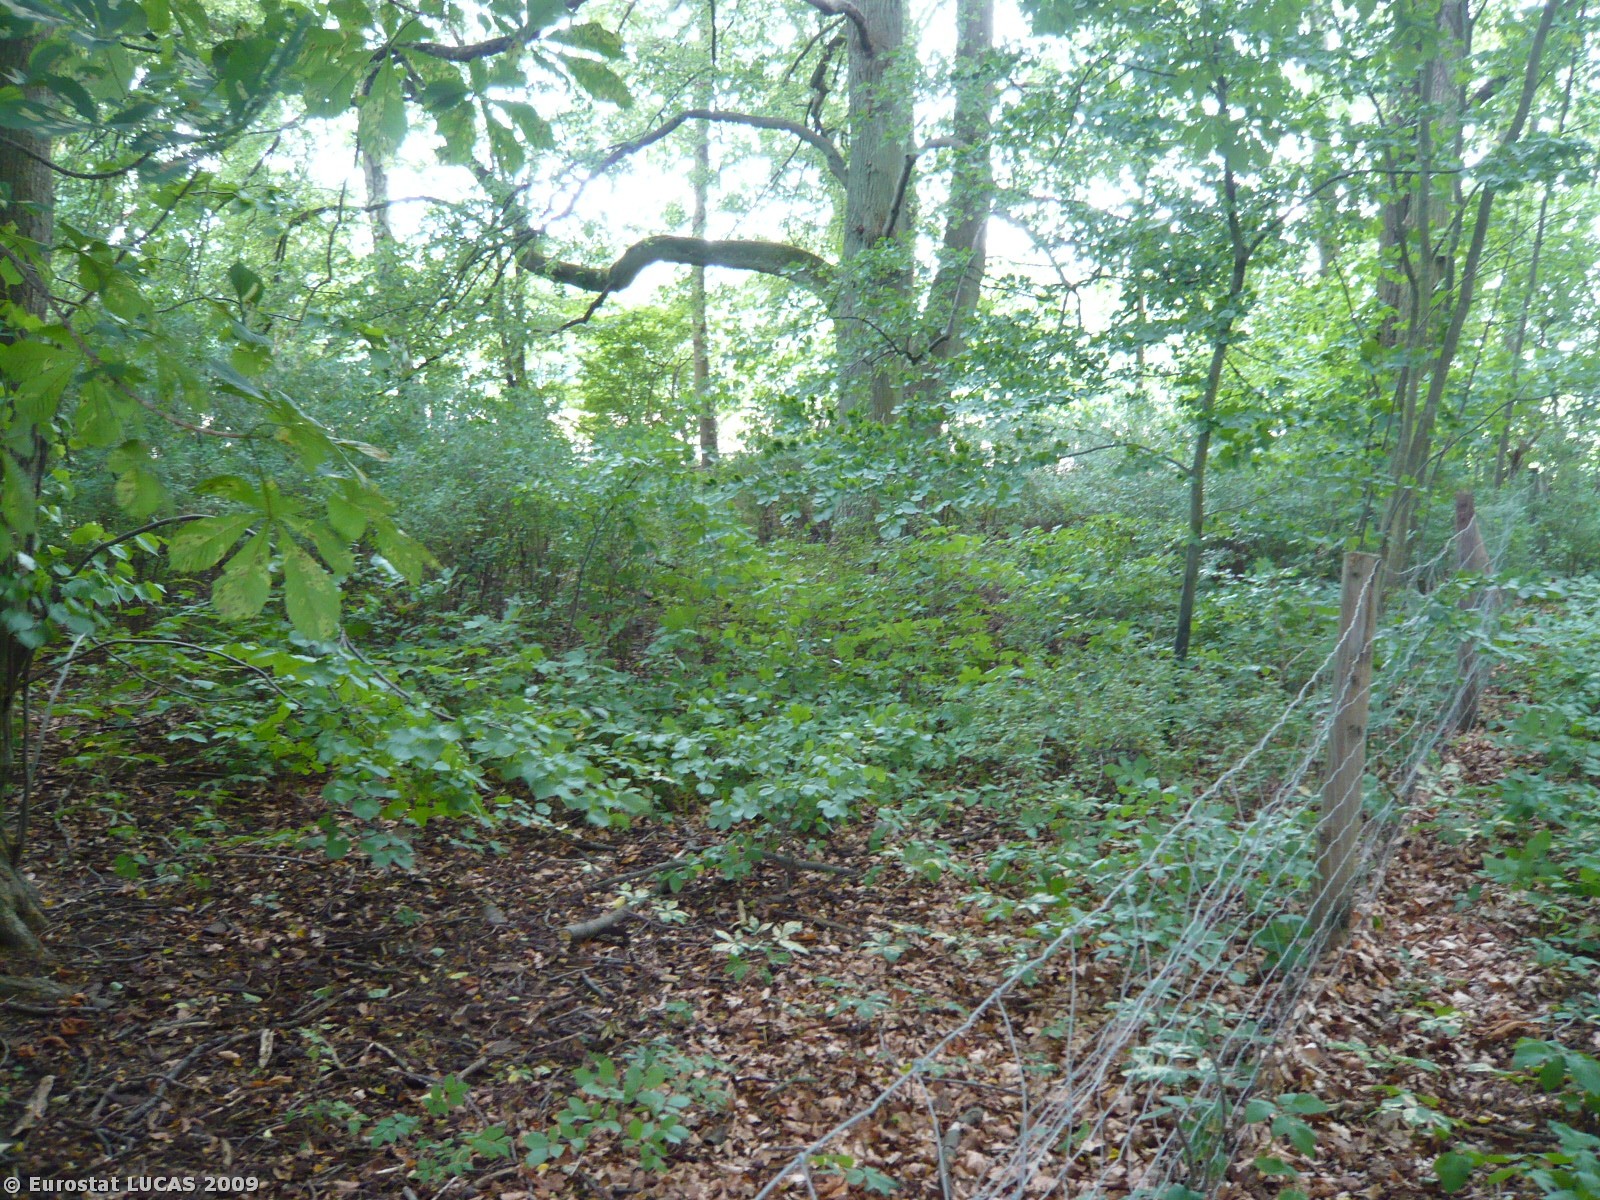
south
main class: Woodland
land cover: Broadleaved woodland
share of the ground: > 75 %
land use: Residential
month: July
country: DK
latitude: 55.4359
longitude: 11.9424
